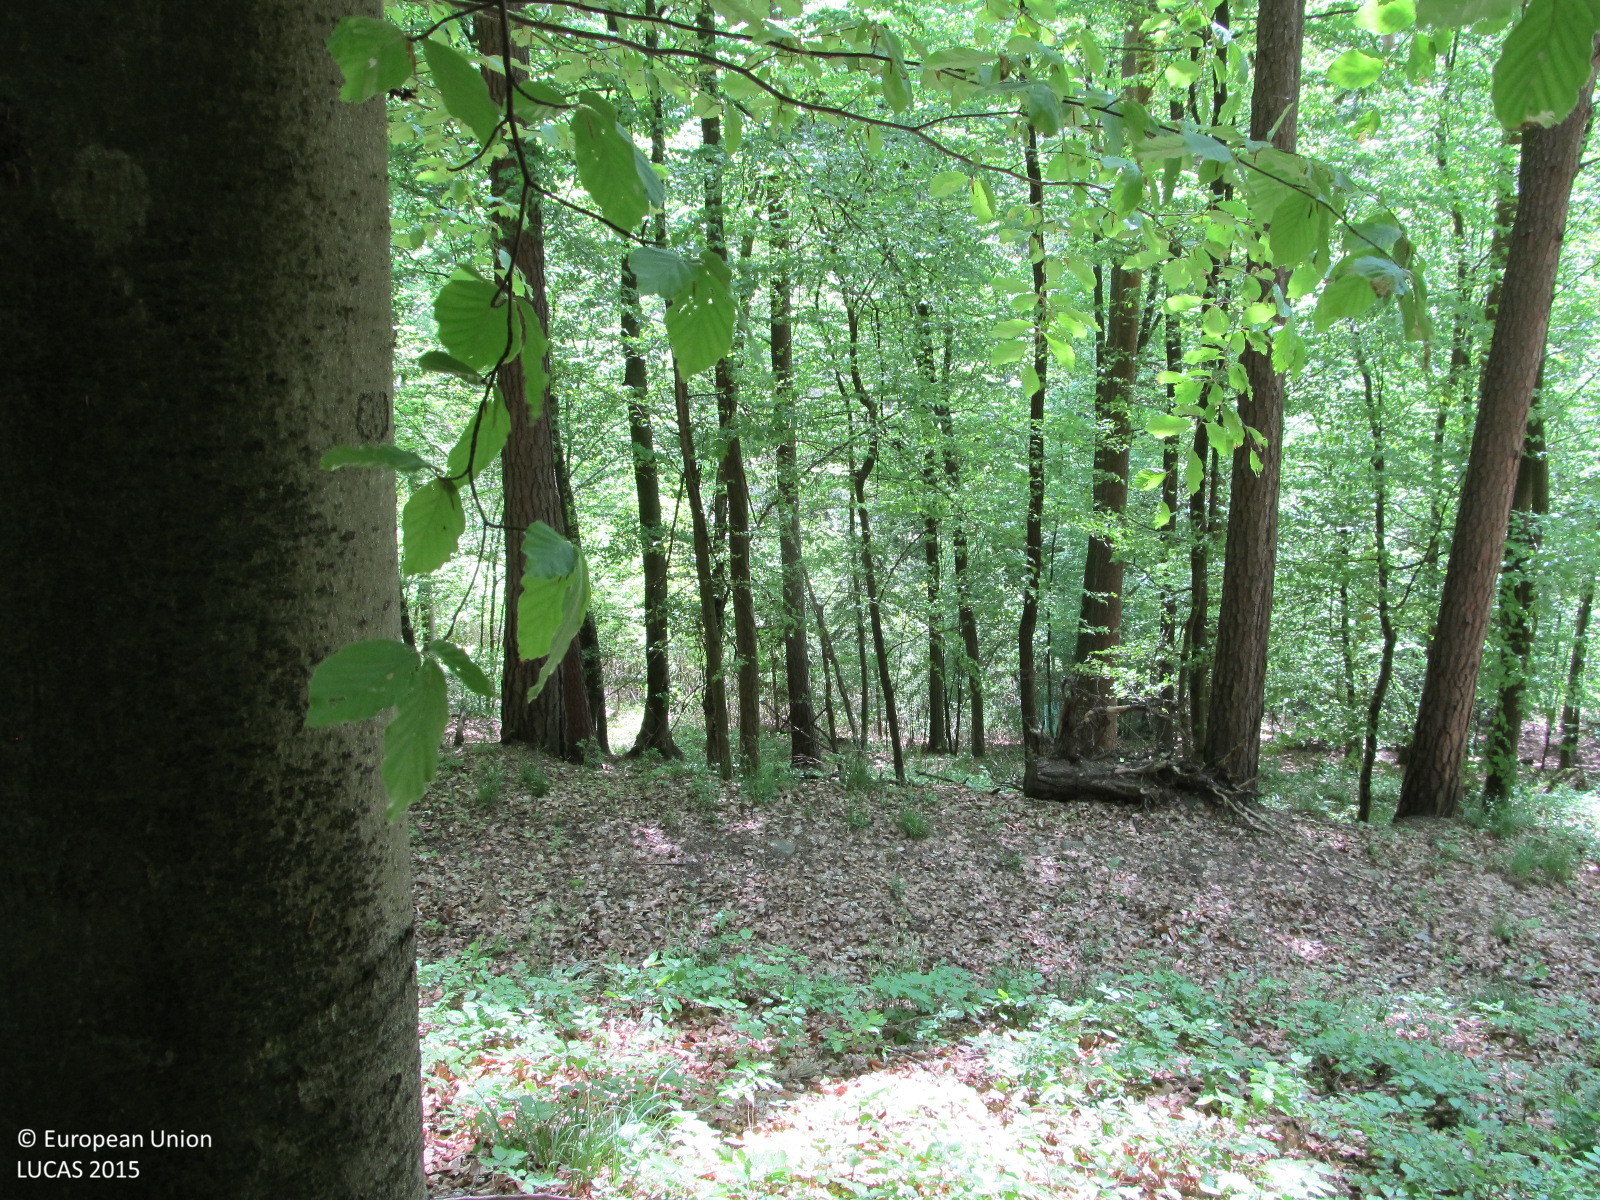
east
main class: Woodland
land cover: Pine dominated mixed woodland
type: beech forest
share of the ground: > 75 %
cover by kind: broadleaved forest trees 60 %, coniferous forest trees 20 %, herbaceous plants 10 %, shrubs 5 %, unconsolidated bare surface 5 %
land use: Forestry
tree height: > 5 m
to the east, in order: Pine dominated mixed woodland; Tracks; Pine dominated mixed woodland; Other mixed woodland; Spruce dominated mixed woodland; Rivers and streams; Spruce dominated mixed woodland; Tracks; Other mixed woodland; Paved roads, cycling and walking lanes; Pine dominated mixed woodland
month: May
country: AT
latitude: 48.5019
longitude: 15.4841
